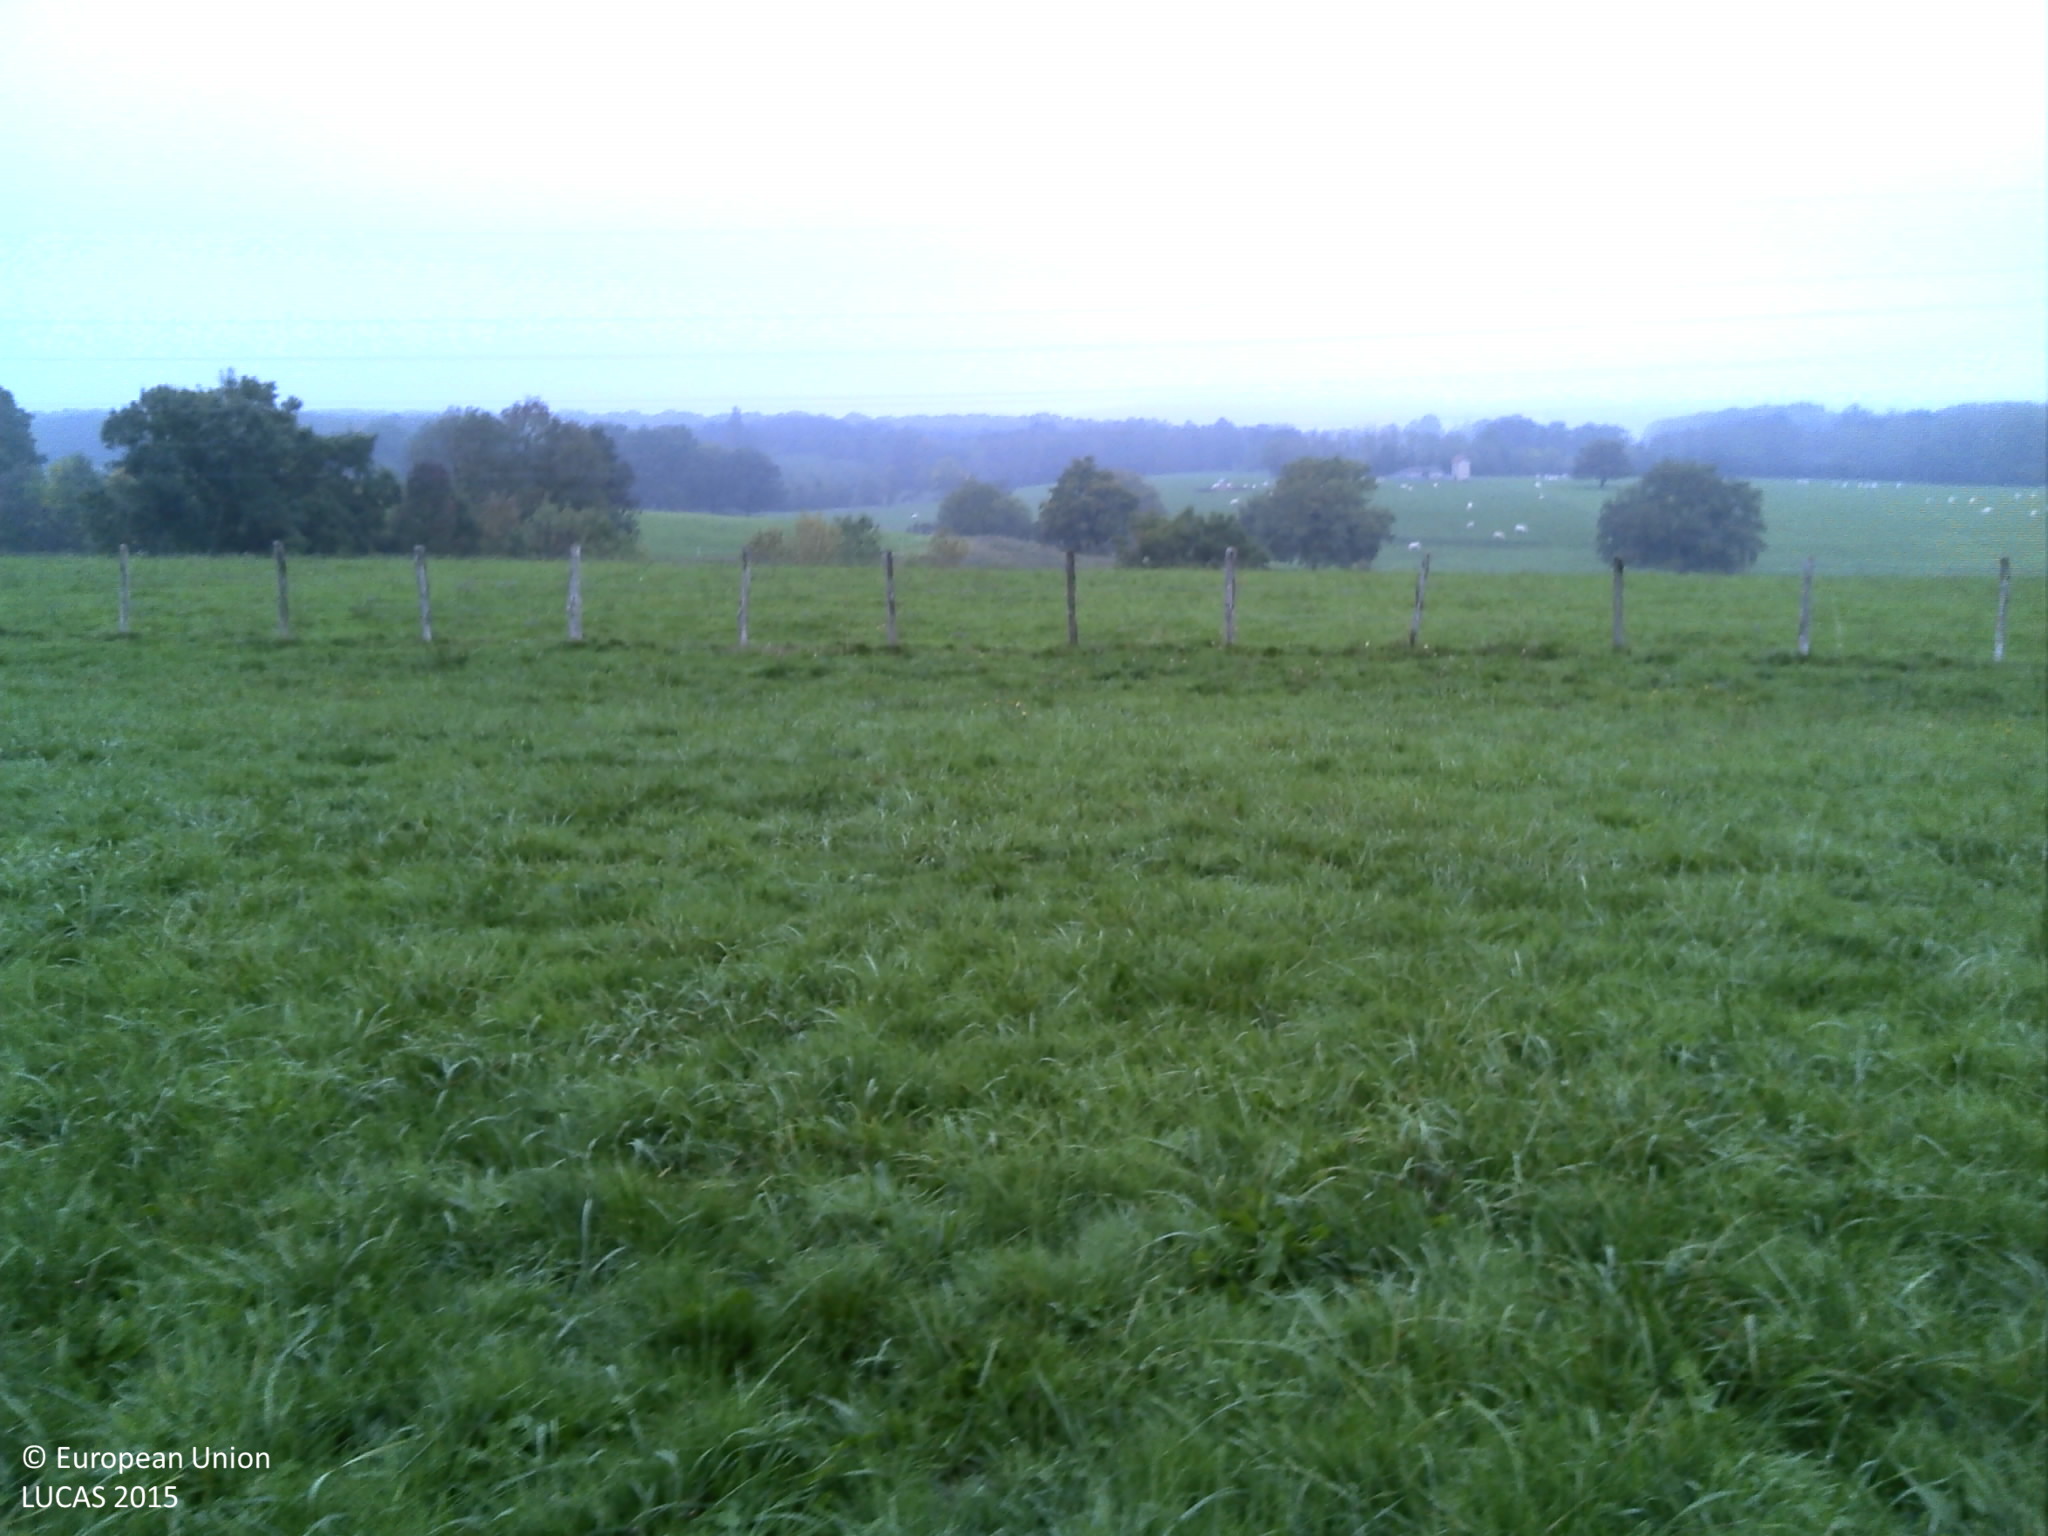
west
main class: Grassland
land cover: Grassland without tree/shrub cover
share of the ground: > 75 %
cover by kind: herbaceous plants 100 %
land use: Agriculture (excluding fallow land and kitchen gardens)
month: October
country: FR
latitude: 46.4263
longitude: 4.8621
